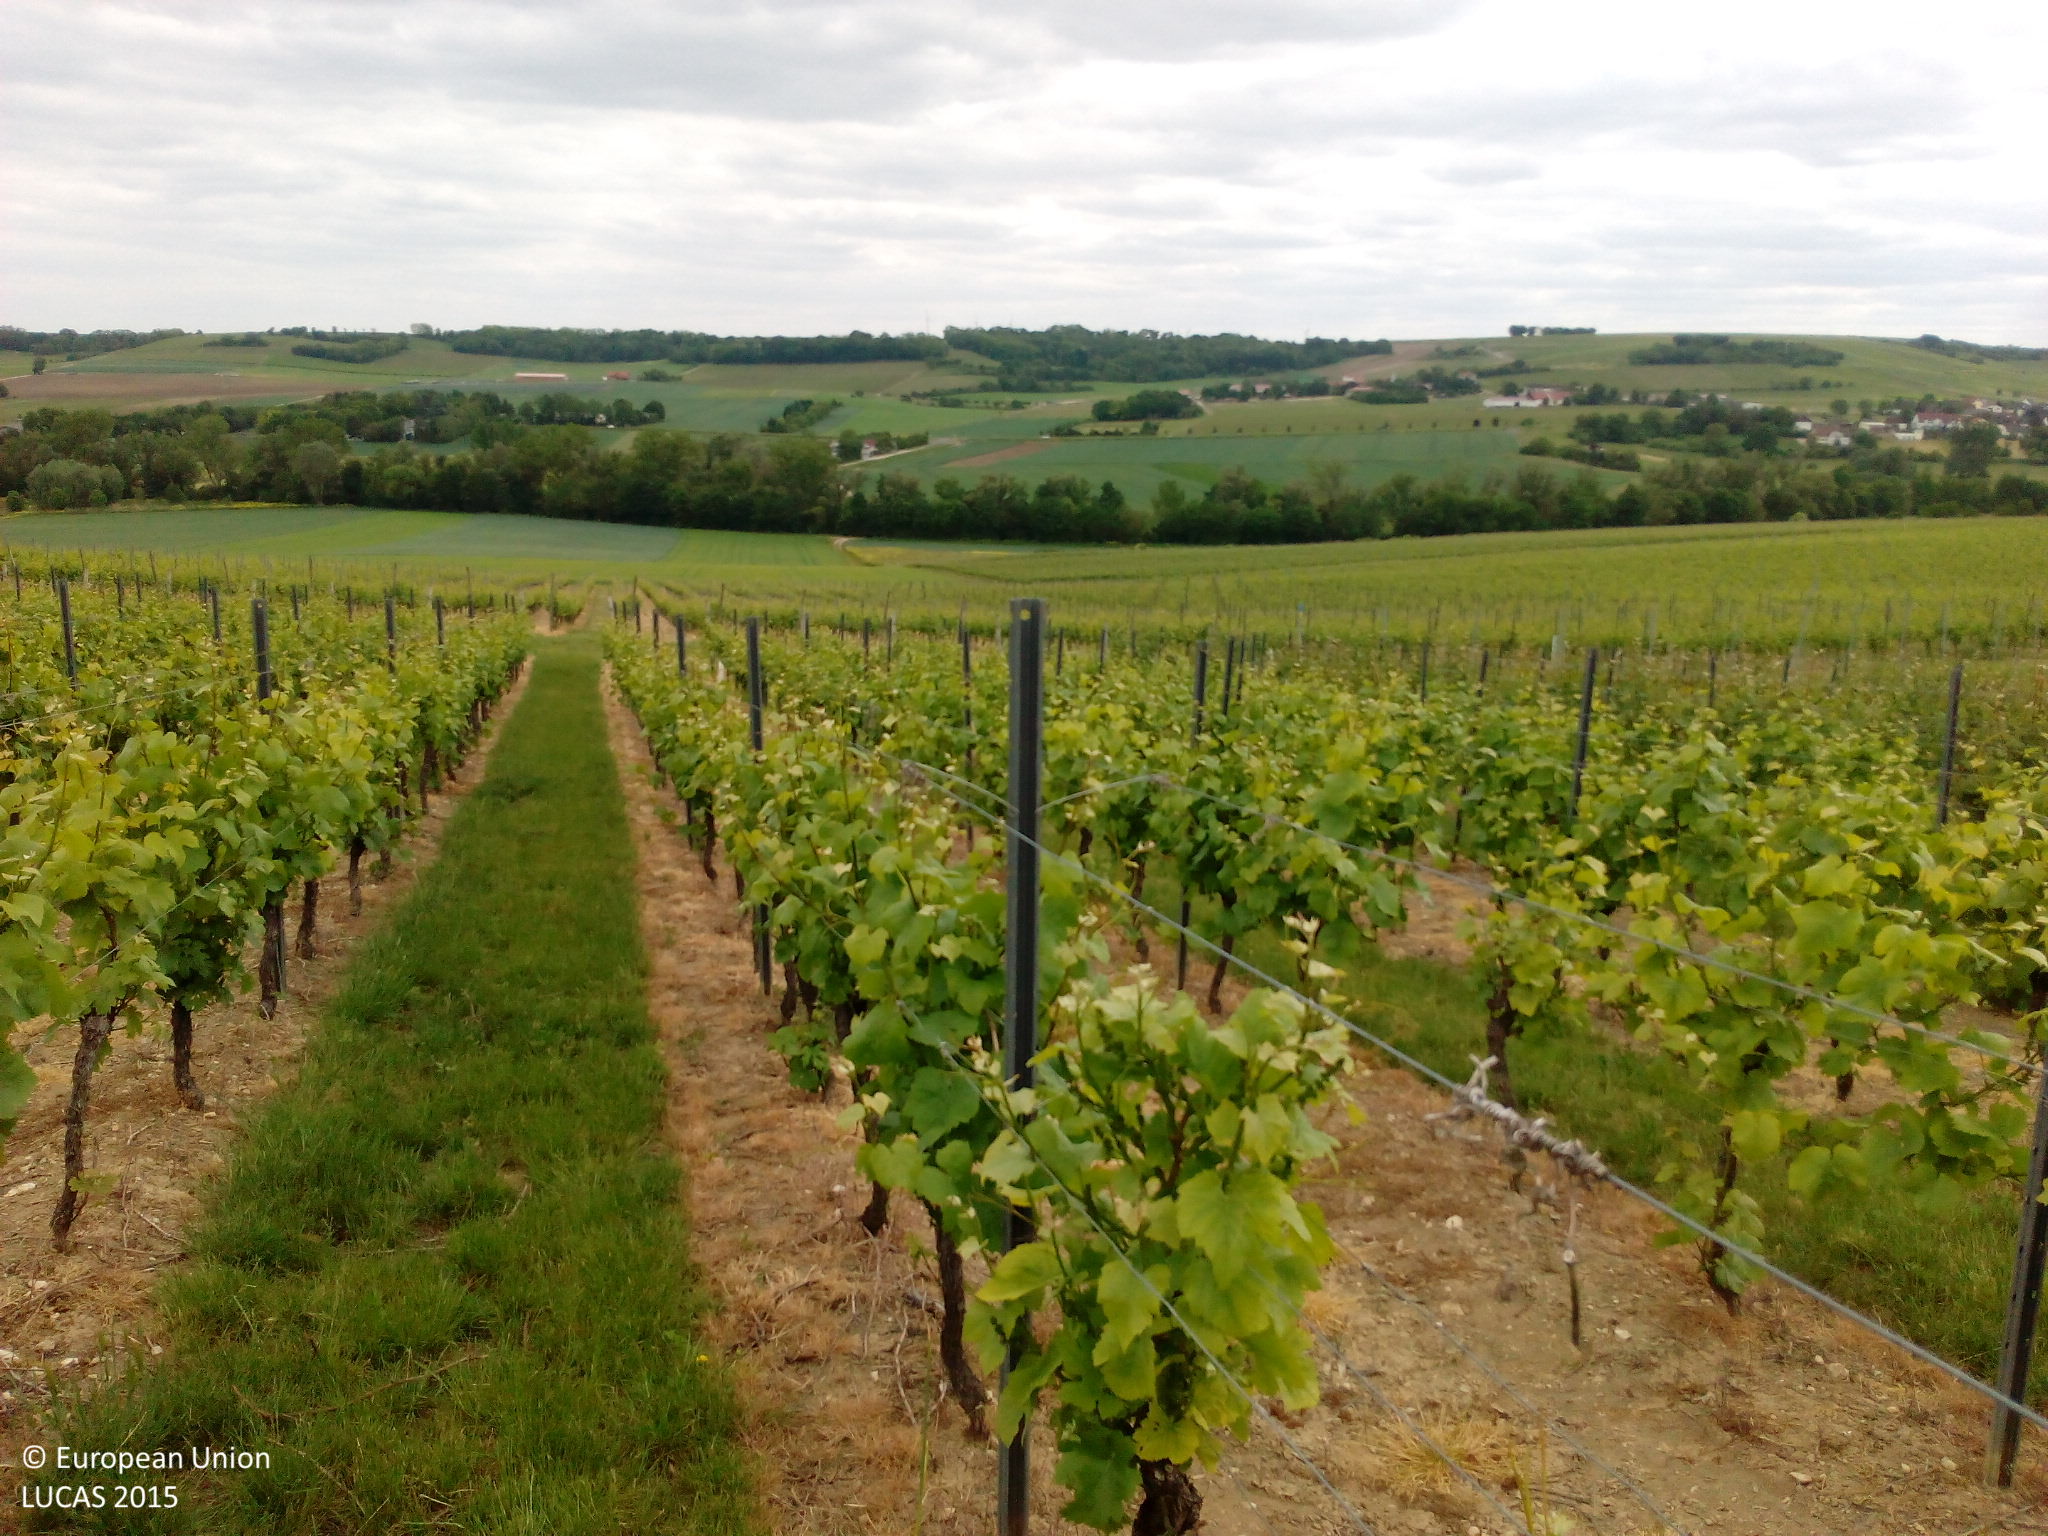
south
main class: Cropland
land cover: Vineyards
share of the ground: 50 - 75 %
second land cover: Grassland without tree/shrub cover
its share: 50 - 75 %
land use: Agriculture (excluding fallow land and kitchen gardens)
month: May
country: DE
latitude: 49.9174
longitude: 8.1481
